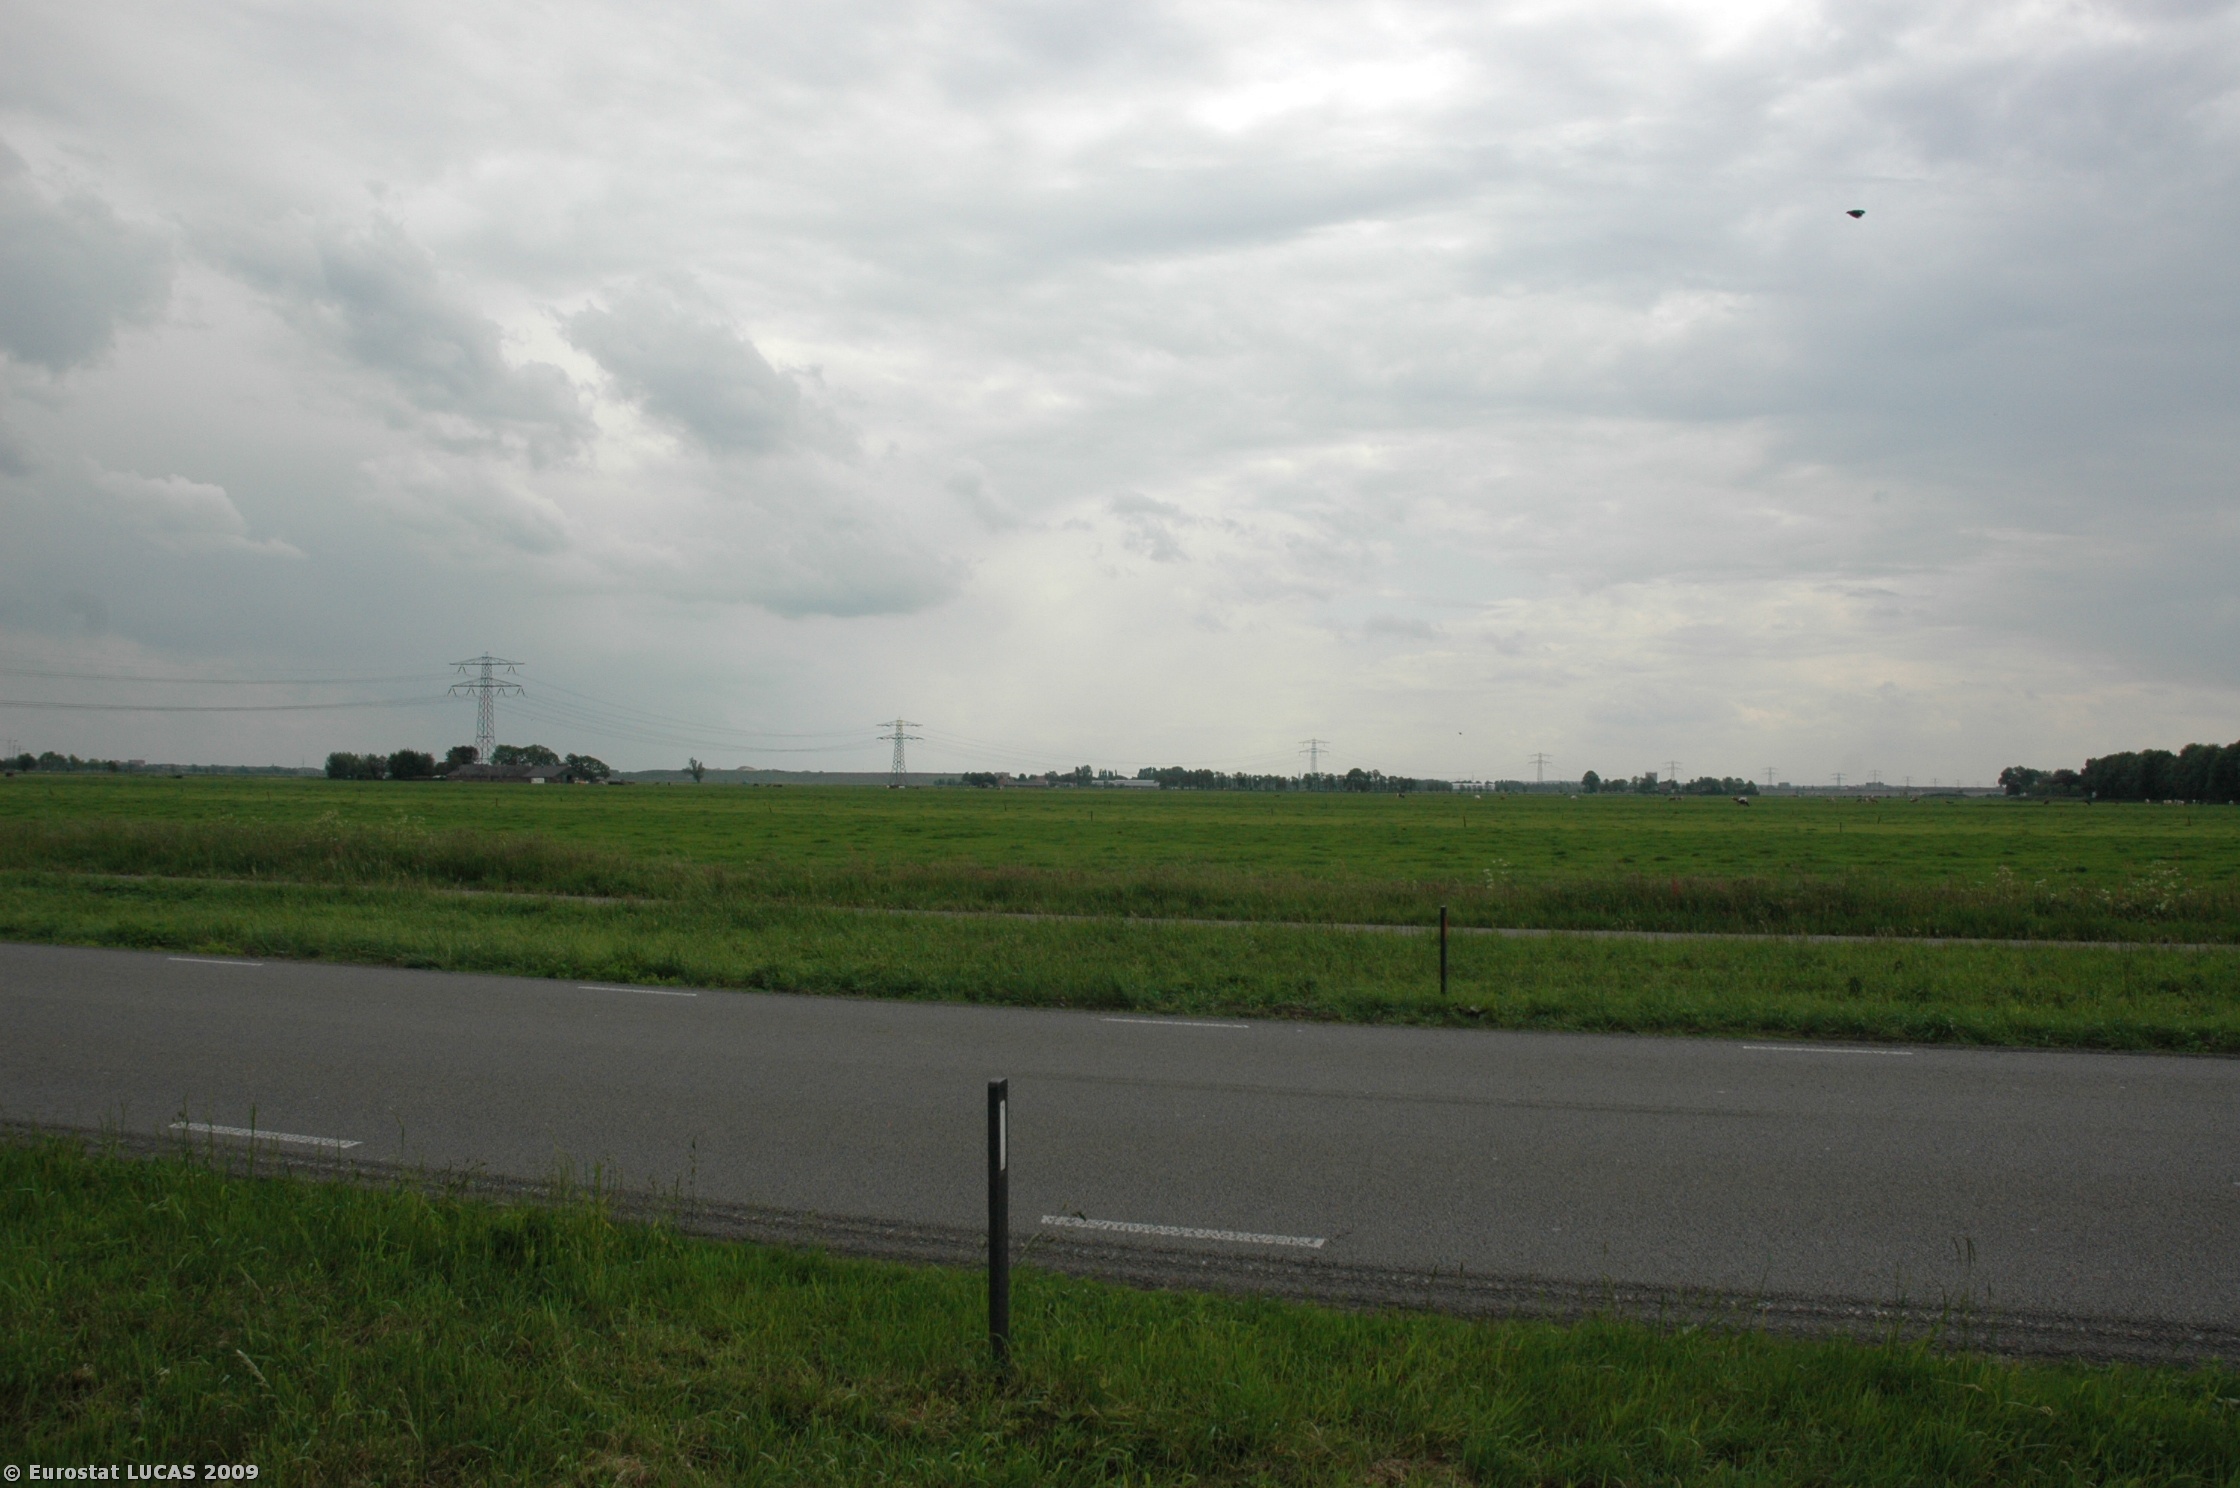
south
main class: Grassland
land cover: Grassland without tree/shrub cover
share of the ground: > 75 %
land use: Agriculture (excluding fallow land and kitchen gardens)
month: May
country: NL
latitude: 52.2338
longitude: 5.3858
